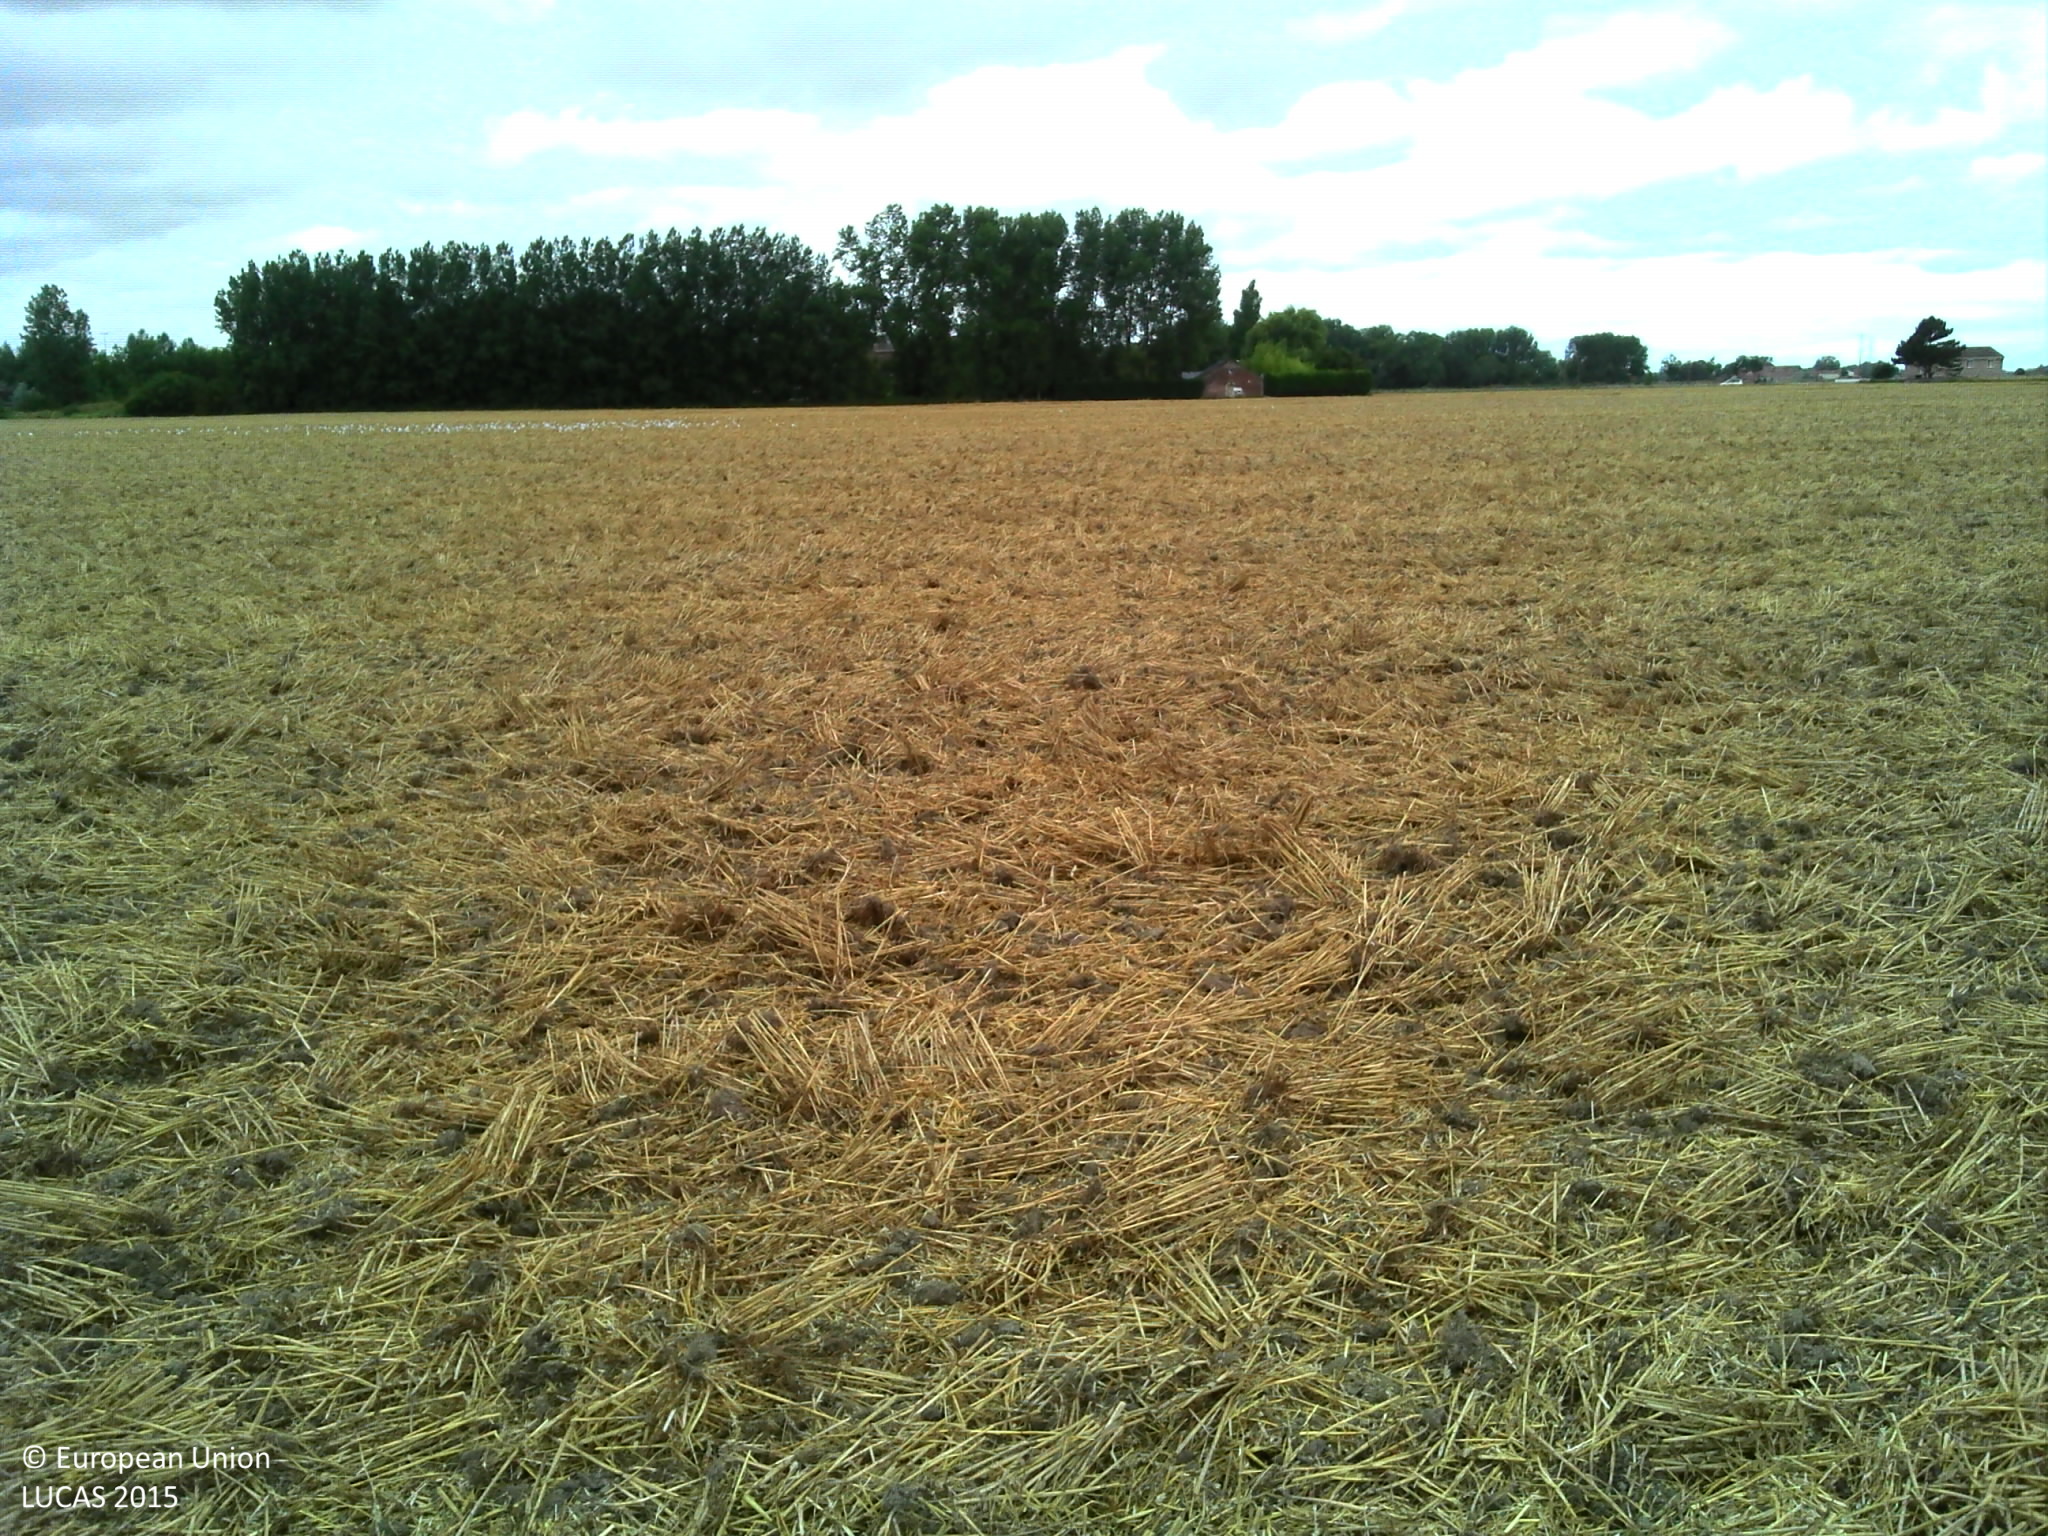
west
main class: Cropland
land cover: Common wheat
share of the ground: 25 - 50 %
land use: Agriculture (excluding fallow land and kitchen gardens)
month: August
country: FR
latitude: 50.9369
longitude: 2.0582
